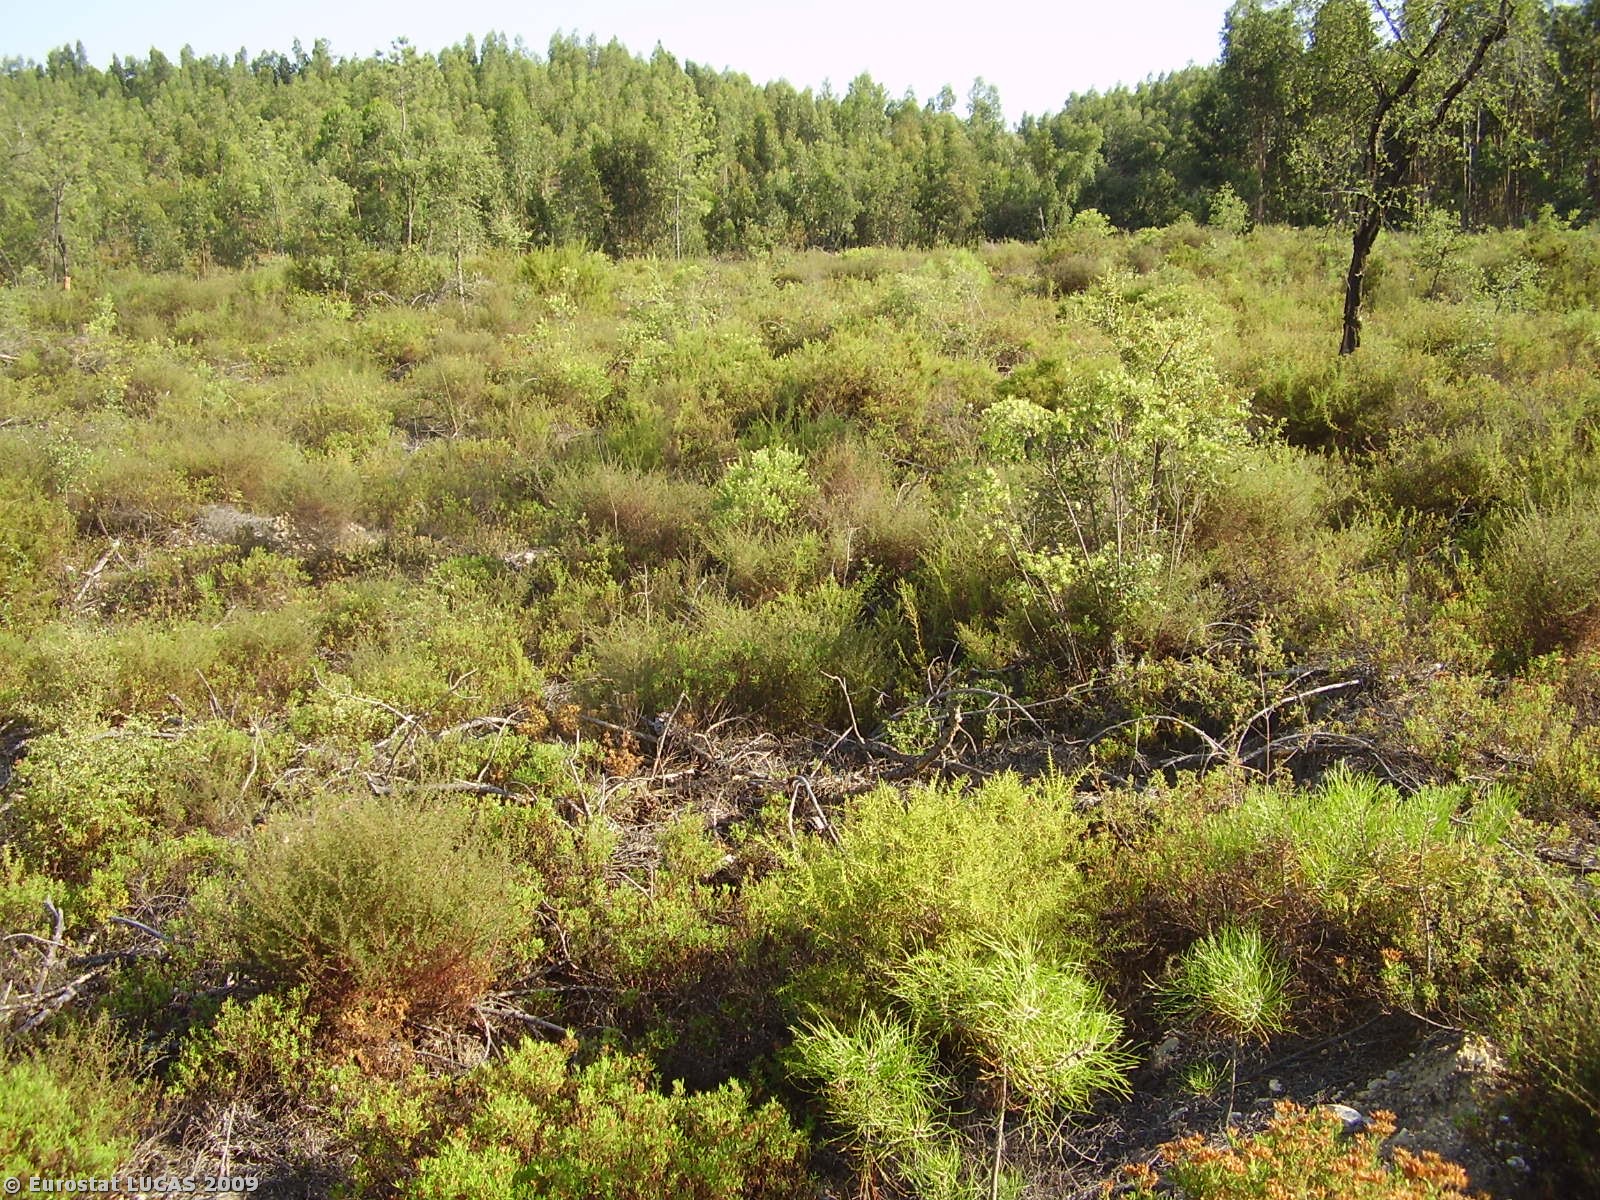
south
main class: Shrubland
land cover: Shrubland with sparse tree cover
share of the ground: > 75 %
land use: Fallow land
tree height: > 5 m
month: July
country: PT
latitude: 39.4403
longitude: -8.0813
